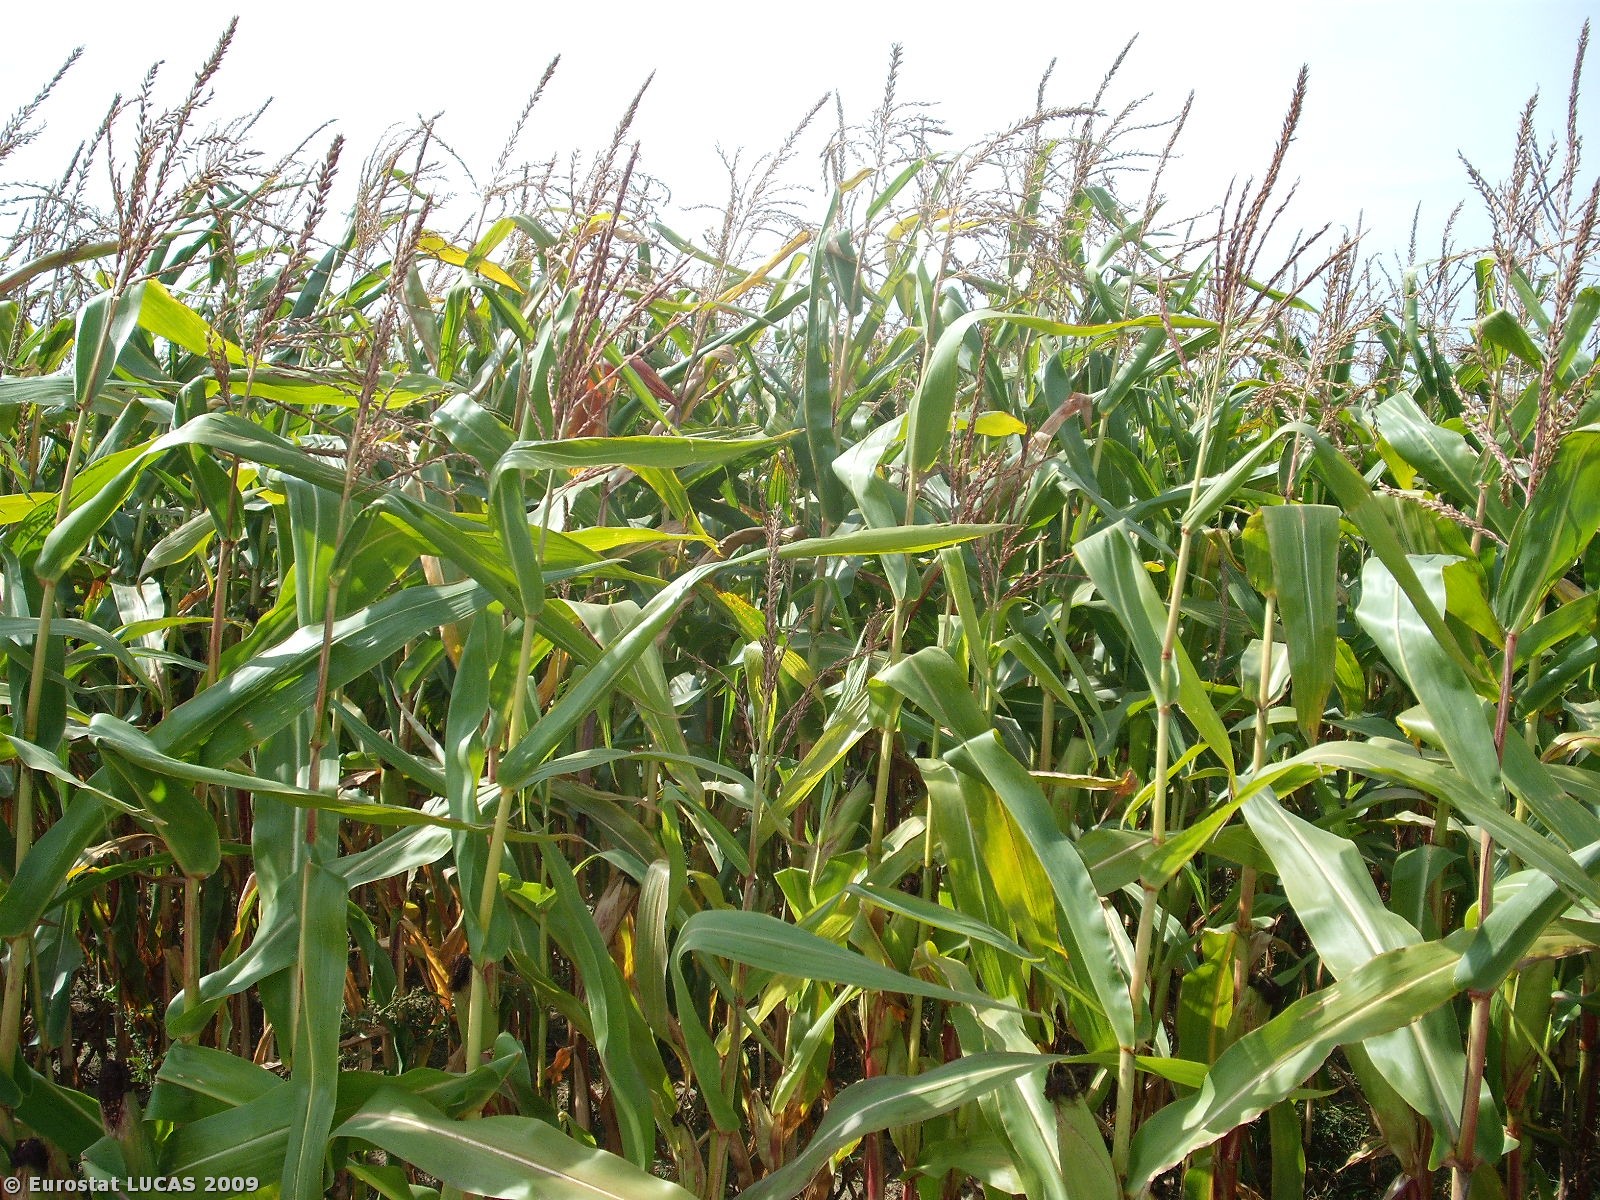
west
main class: Cropland
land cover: Maize
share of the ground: > 75 %
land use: Agriculture (excluding fallow land and kitchen gardens)
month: September
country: PL
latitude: 51.8767
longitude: 22.1610
